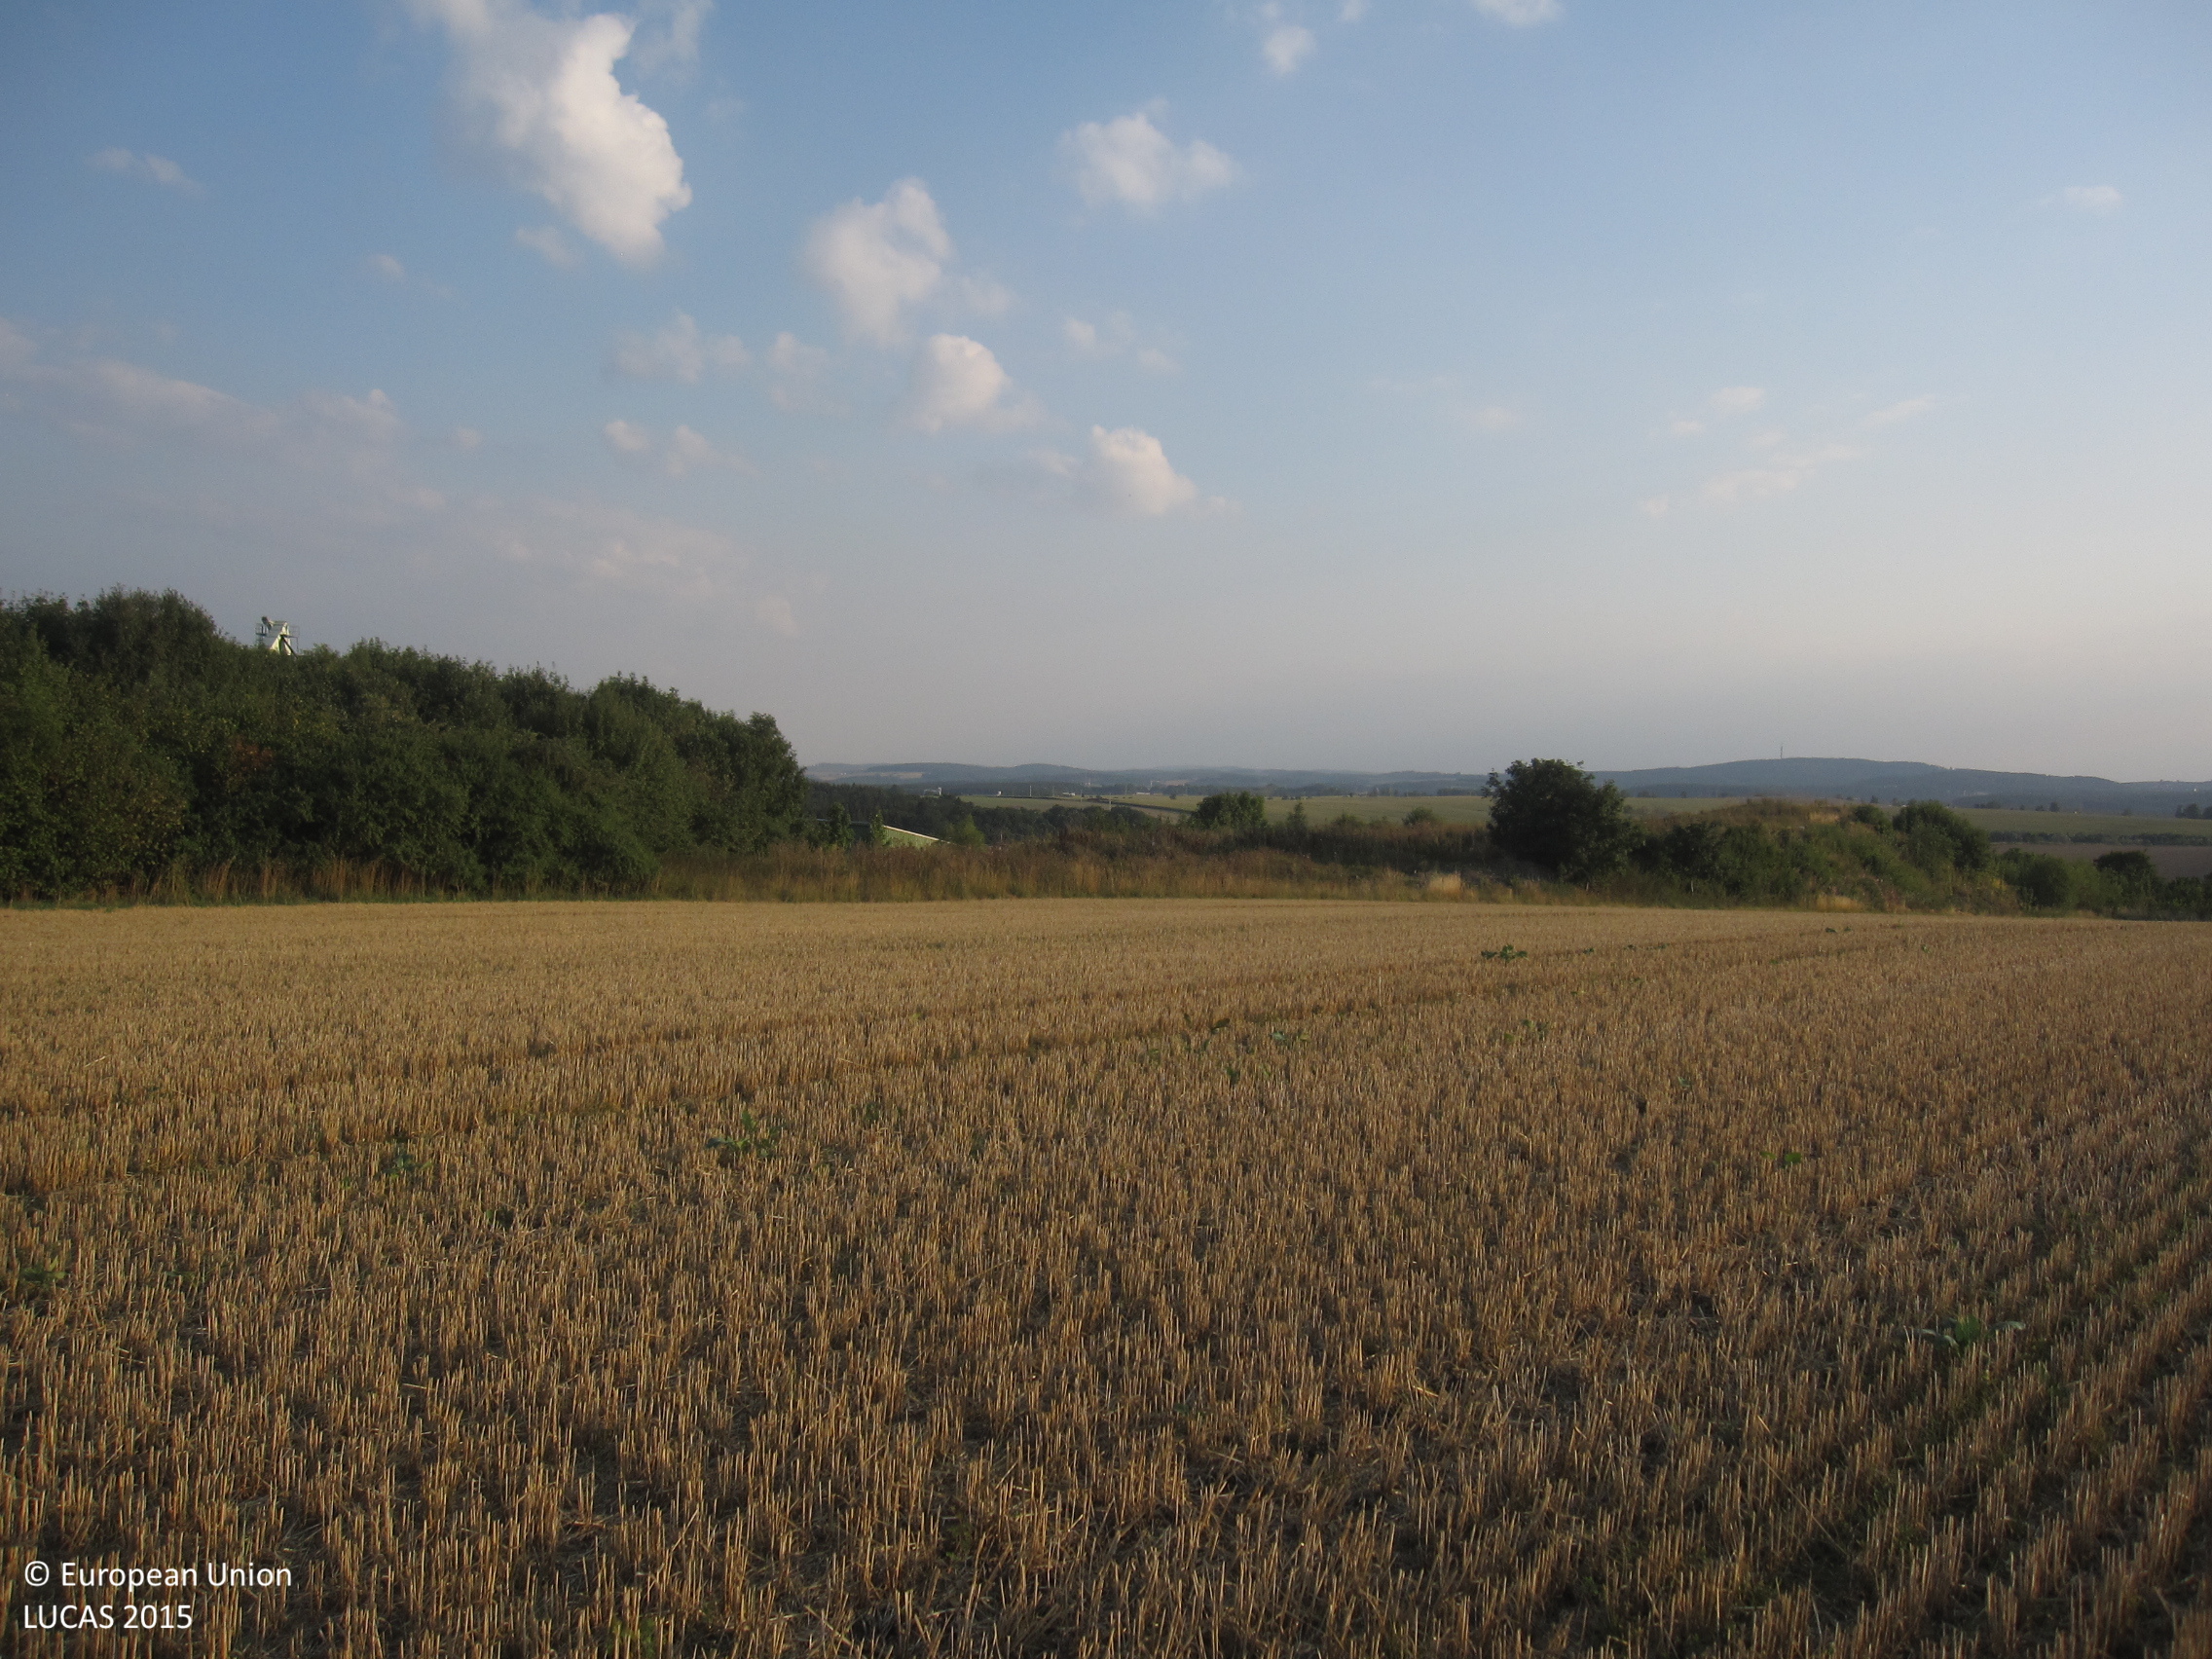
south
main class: Cropland
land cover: Barley
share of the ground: 10 - 25 %
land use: Agriculture (excluding fallow land and kitchen gardens)
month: August
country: DE
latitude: 50.4960
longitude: 11.6490
